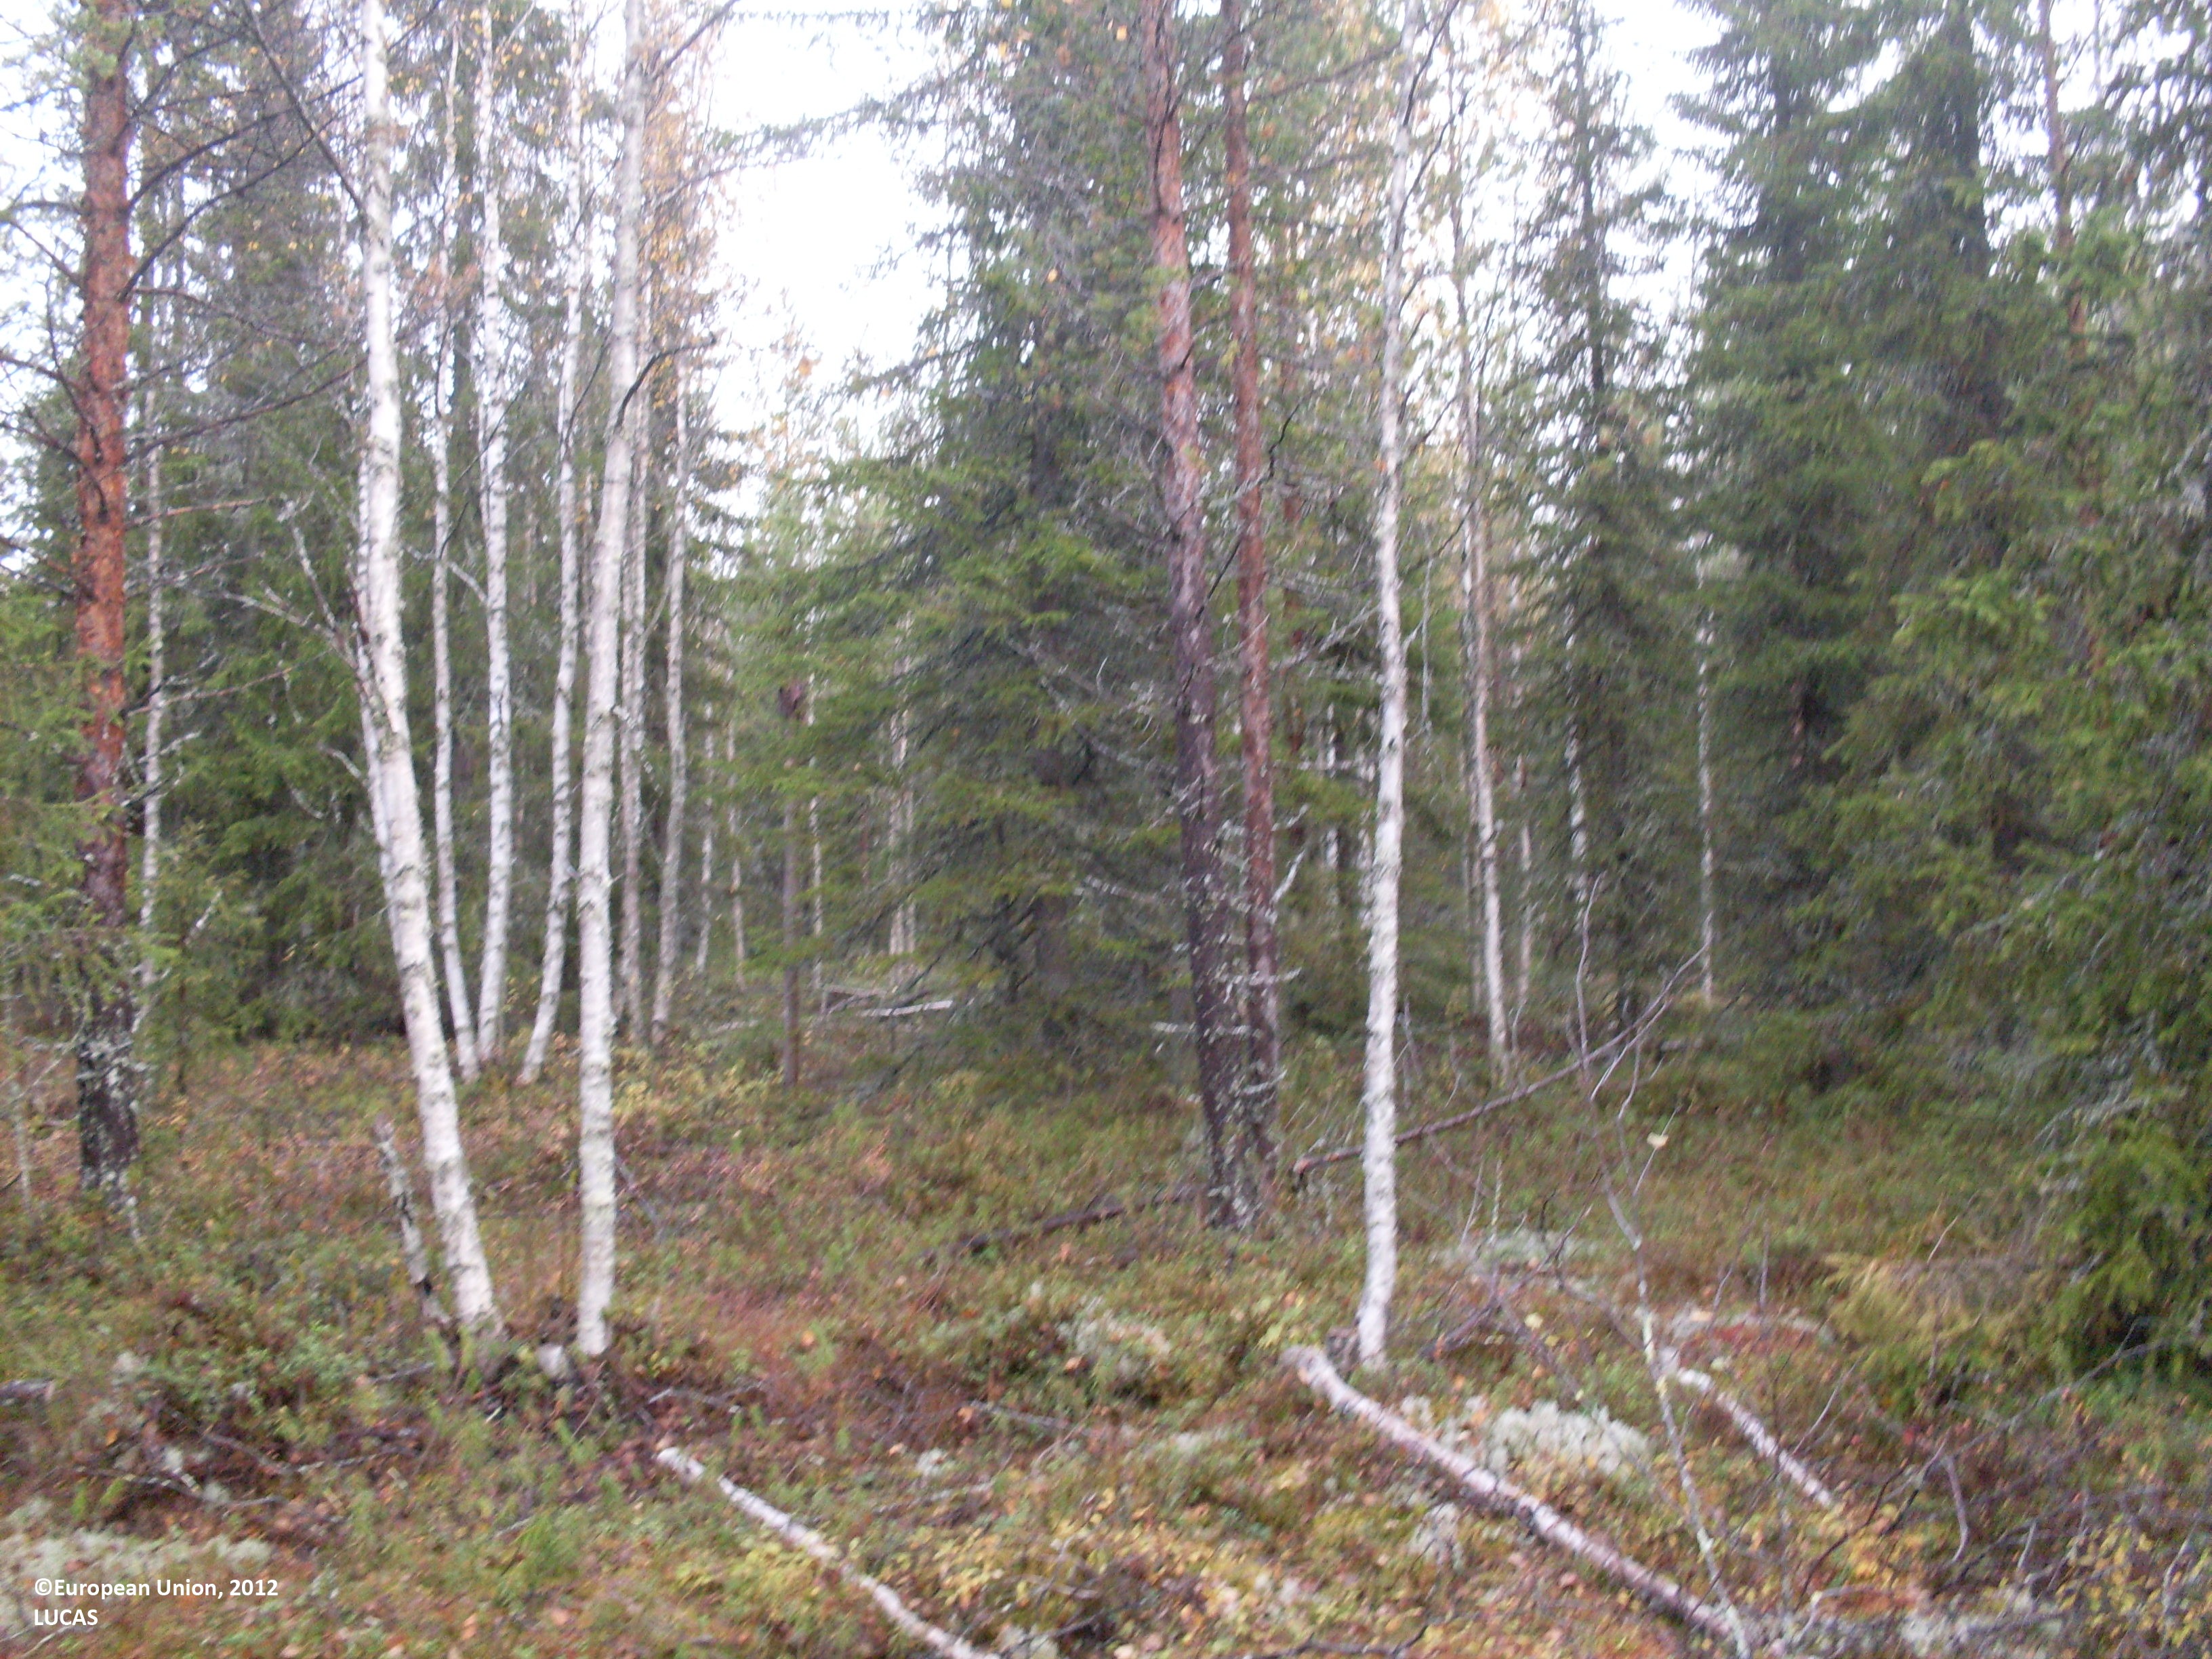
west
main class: Woodland
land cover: Pine dominated mixed woodland
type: boreal forest
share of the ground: 25 - 50 %
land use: Forestry
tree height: > 5 m
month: September
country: FI
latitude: 64.4616
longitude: 28.5779
